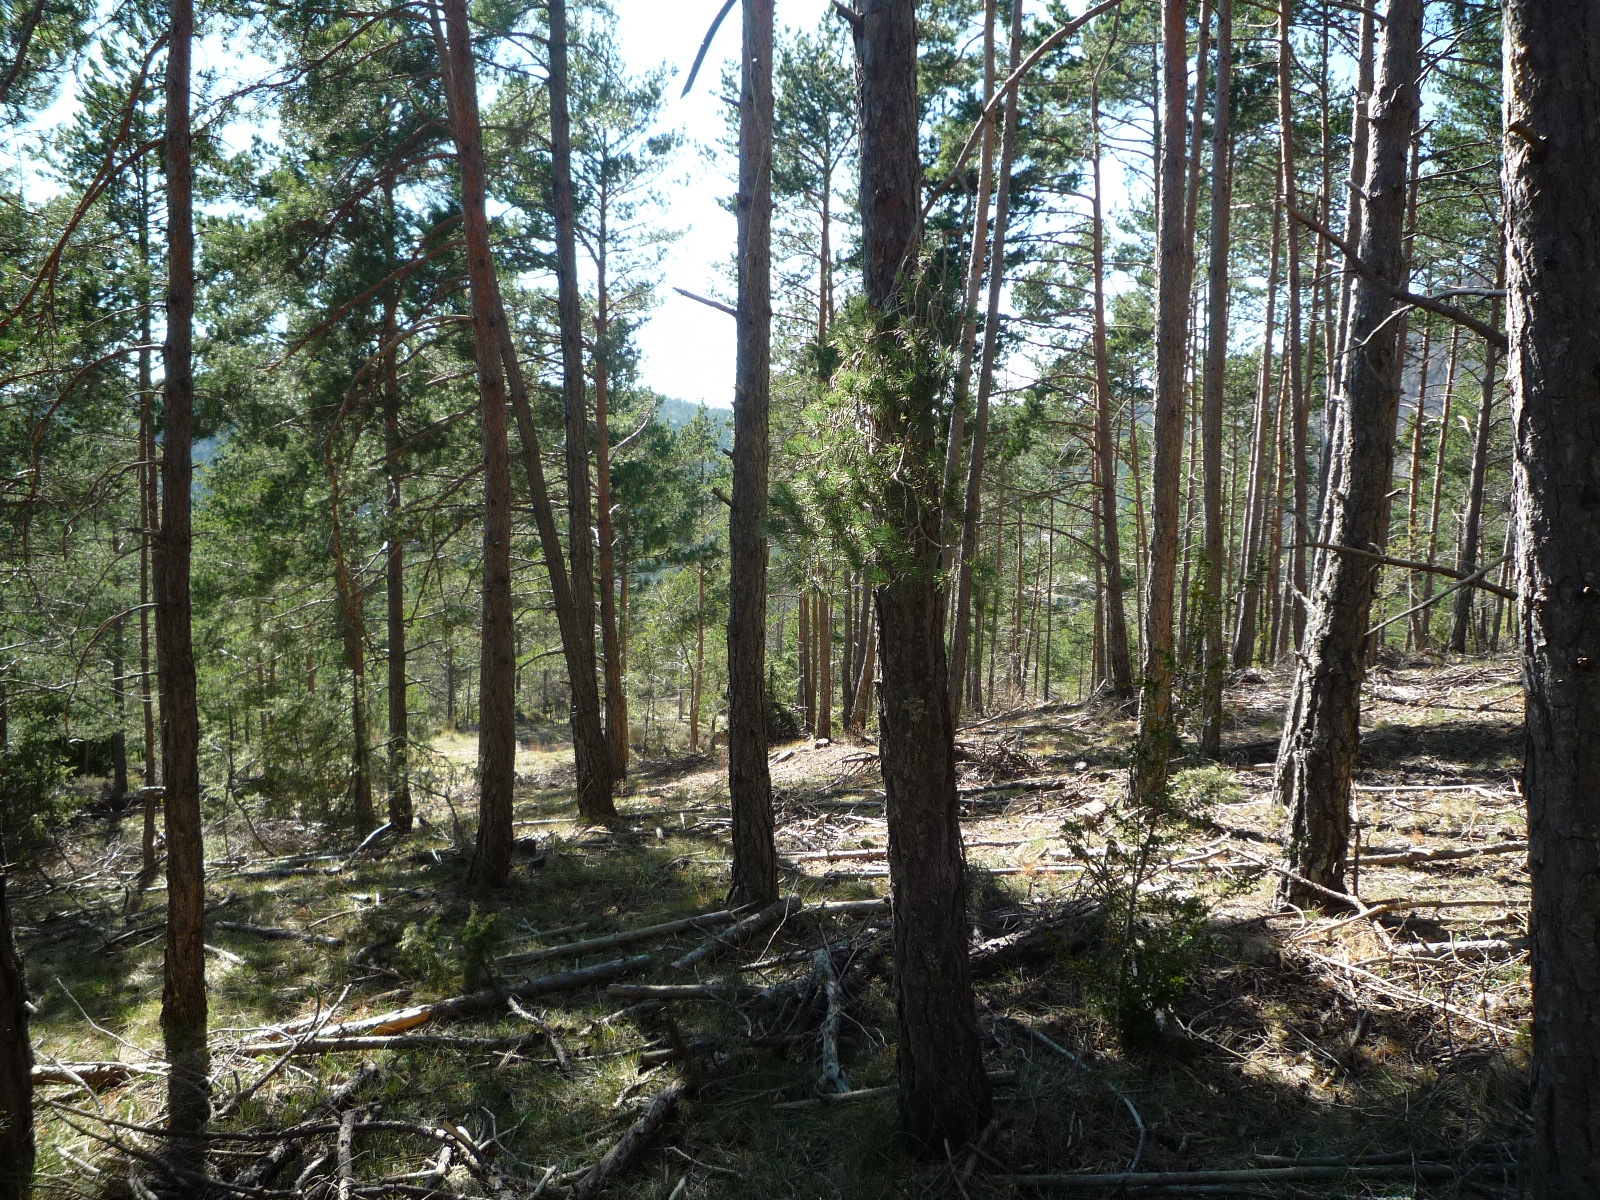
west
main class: Woodland
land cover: Pine dominated coniferous woodland
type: coniferous forest of the mediterranean region
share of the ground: > 75 %
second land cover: Spontaneously vegetated surfaces
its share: 25 - 50 %
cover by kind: coniferous forest trees 75 %, herbaceous plants 25 %
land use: Forestry
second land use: Agriculture (excluding fallow land and kitchen gardens)
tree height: > 5 m
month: March
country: ES
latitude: 42.0896
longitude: 1.6341
